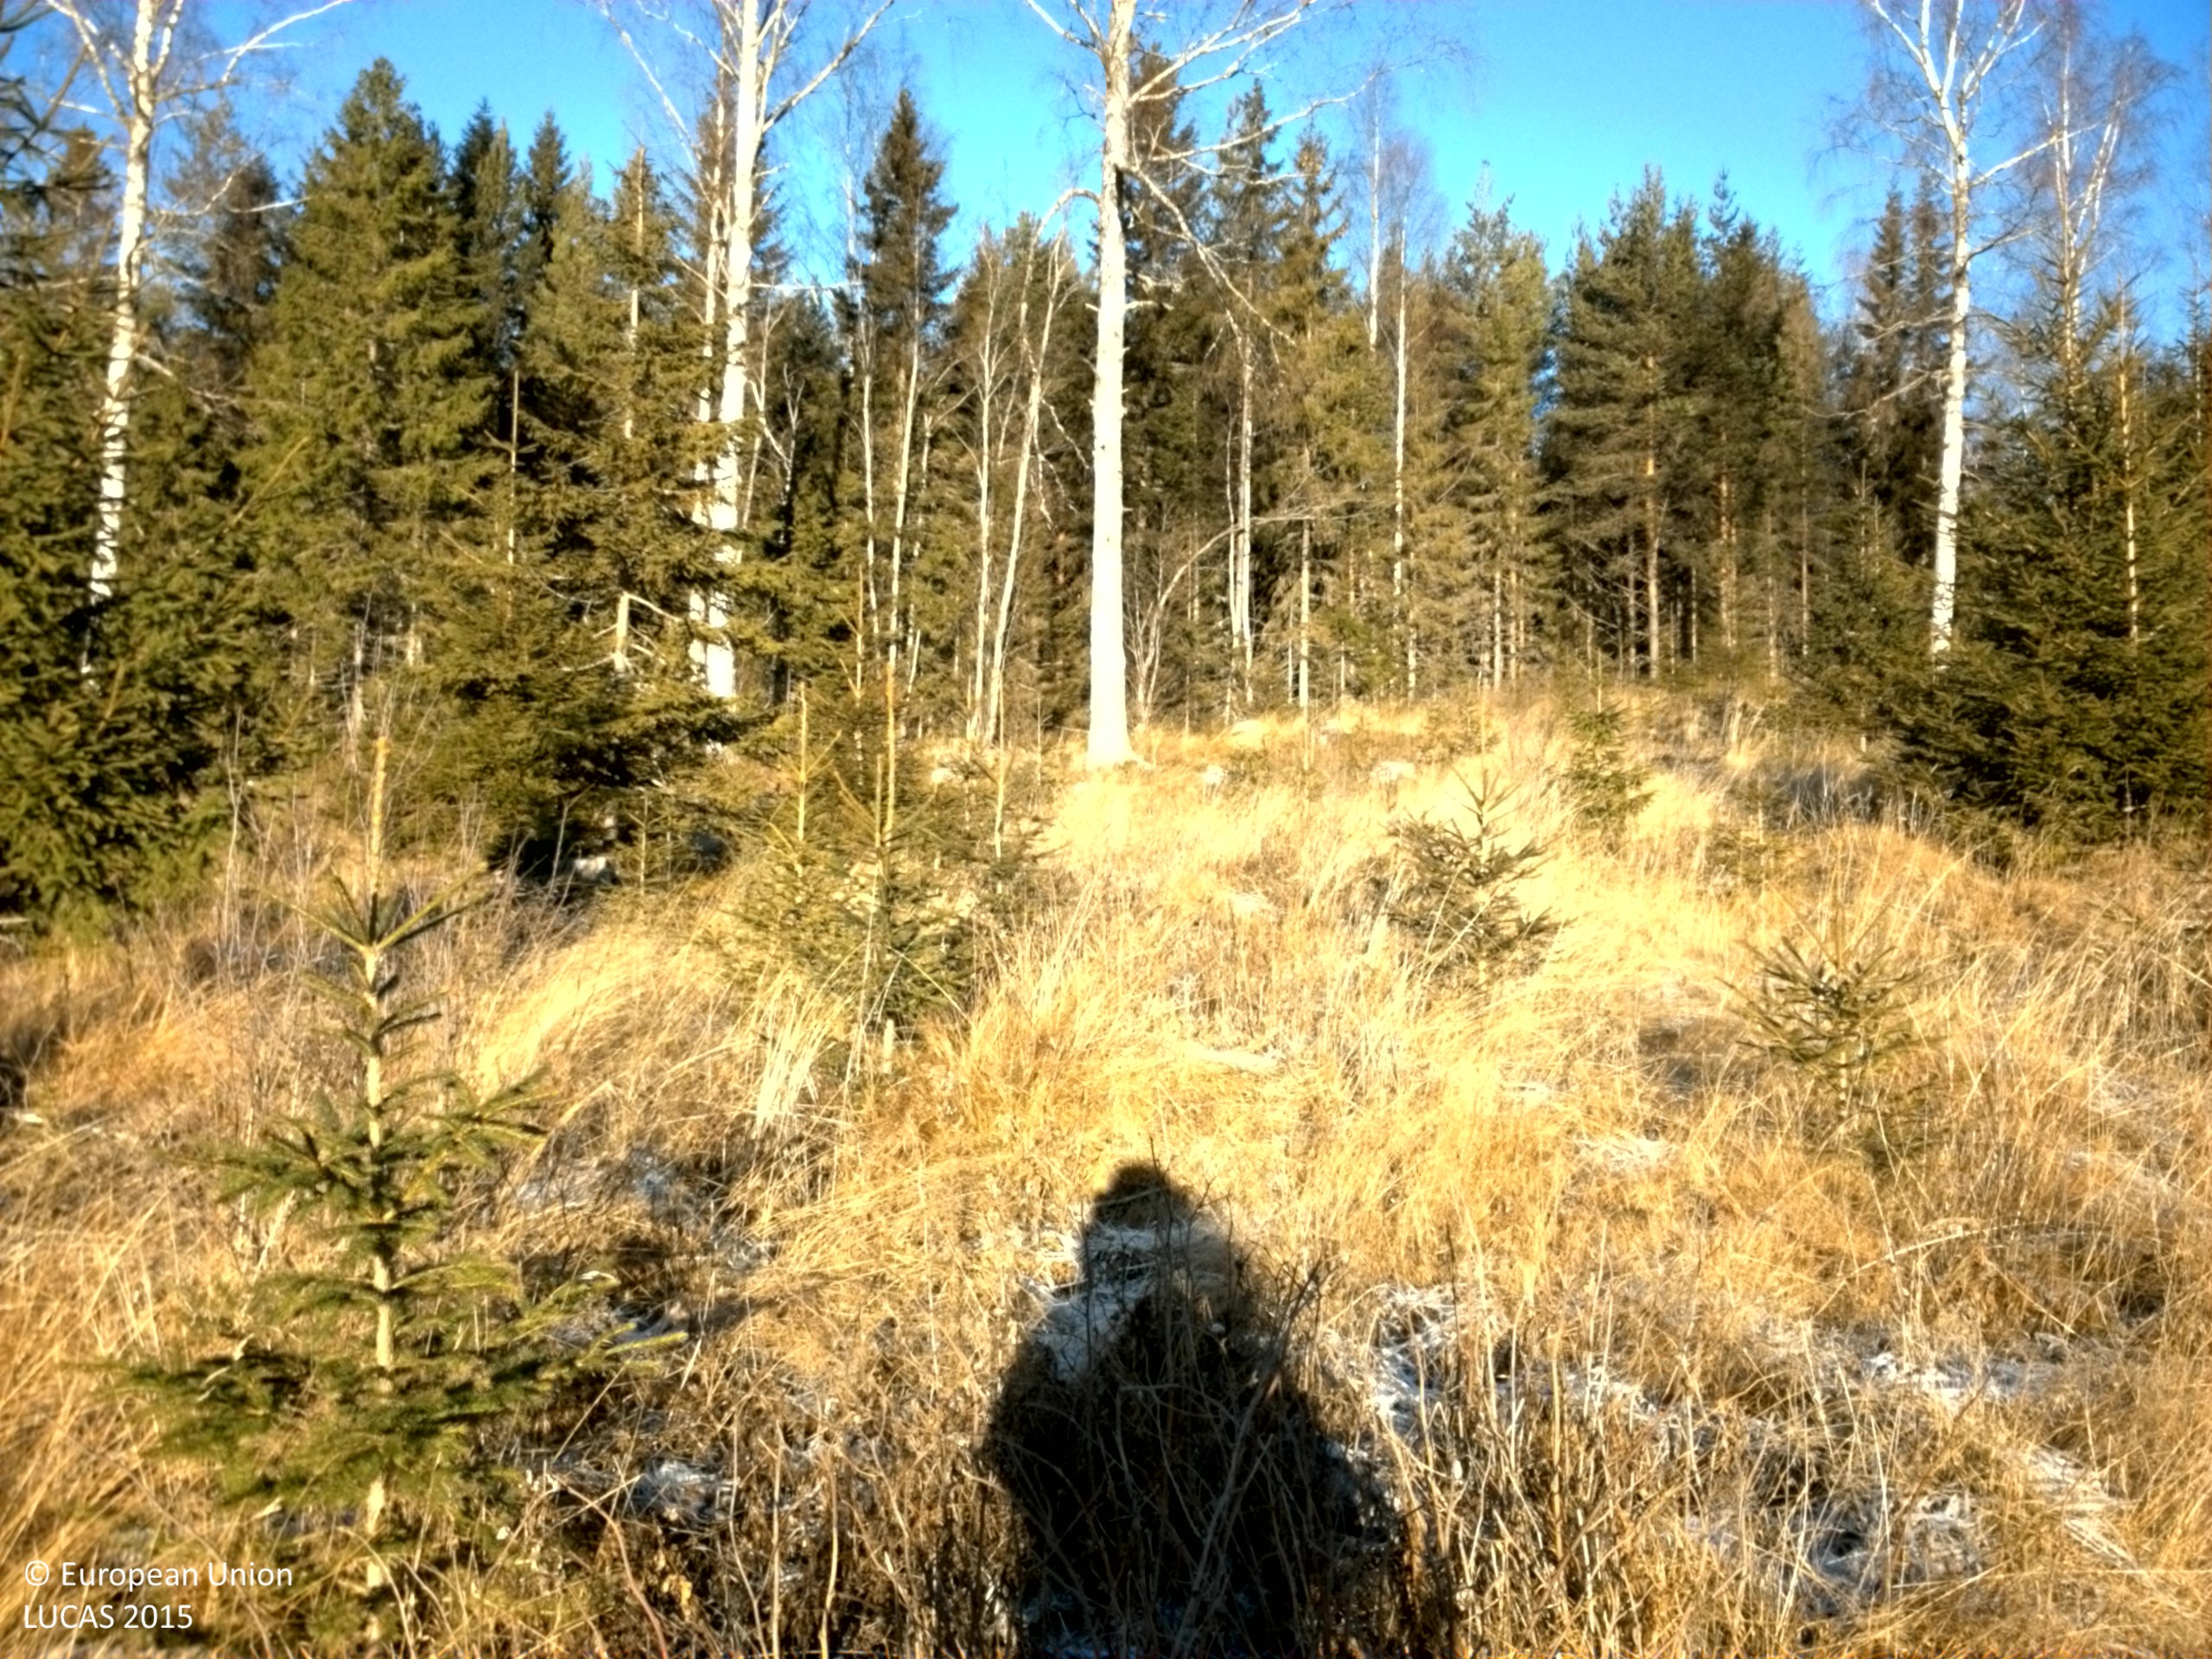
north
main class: Woodland
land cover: Spruce dominated mixed woodland
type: boreal forest
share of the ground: 25 - 50 %
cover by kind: herbaceous plants 50 %, coniferous forest trees 25 %, broadleaved forest trees 10 %, lichens and mosses 10 %, shrubs 5 %
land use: Forestry
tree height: < 5 m
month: November
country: SE
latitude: 61.8877
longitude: 16.2029
